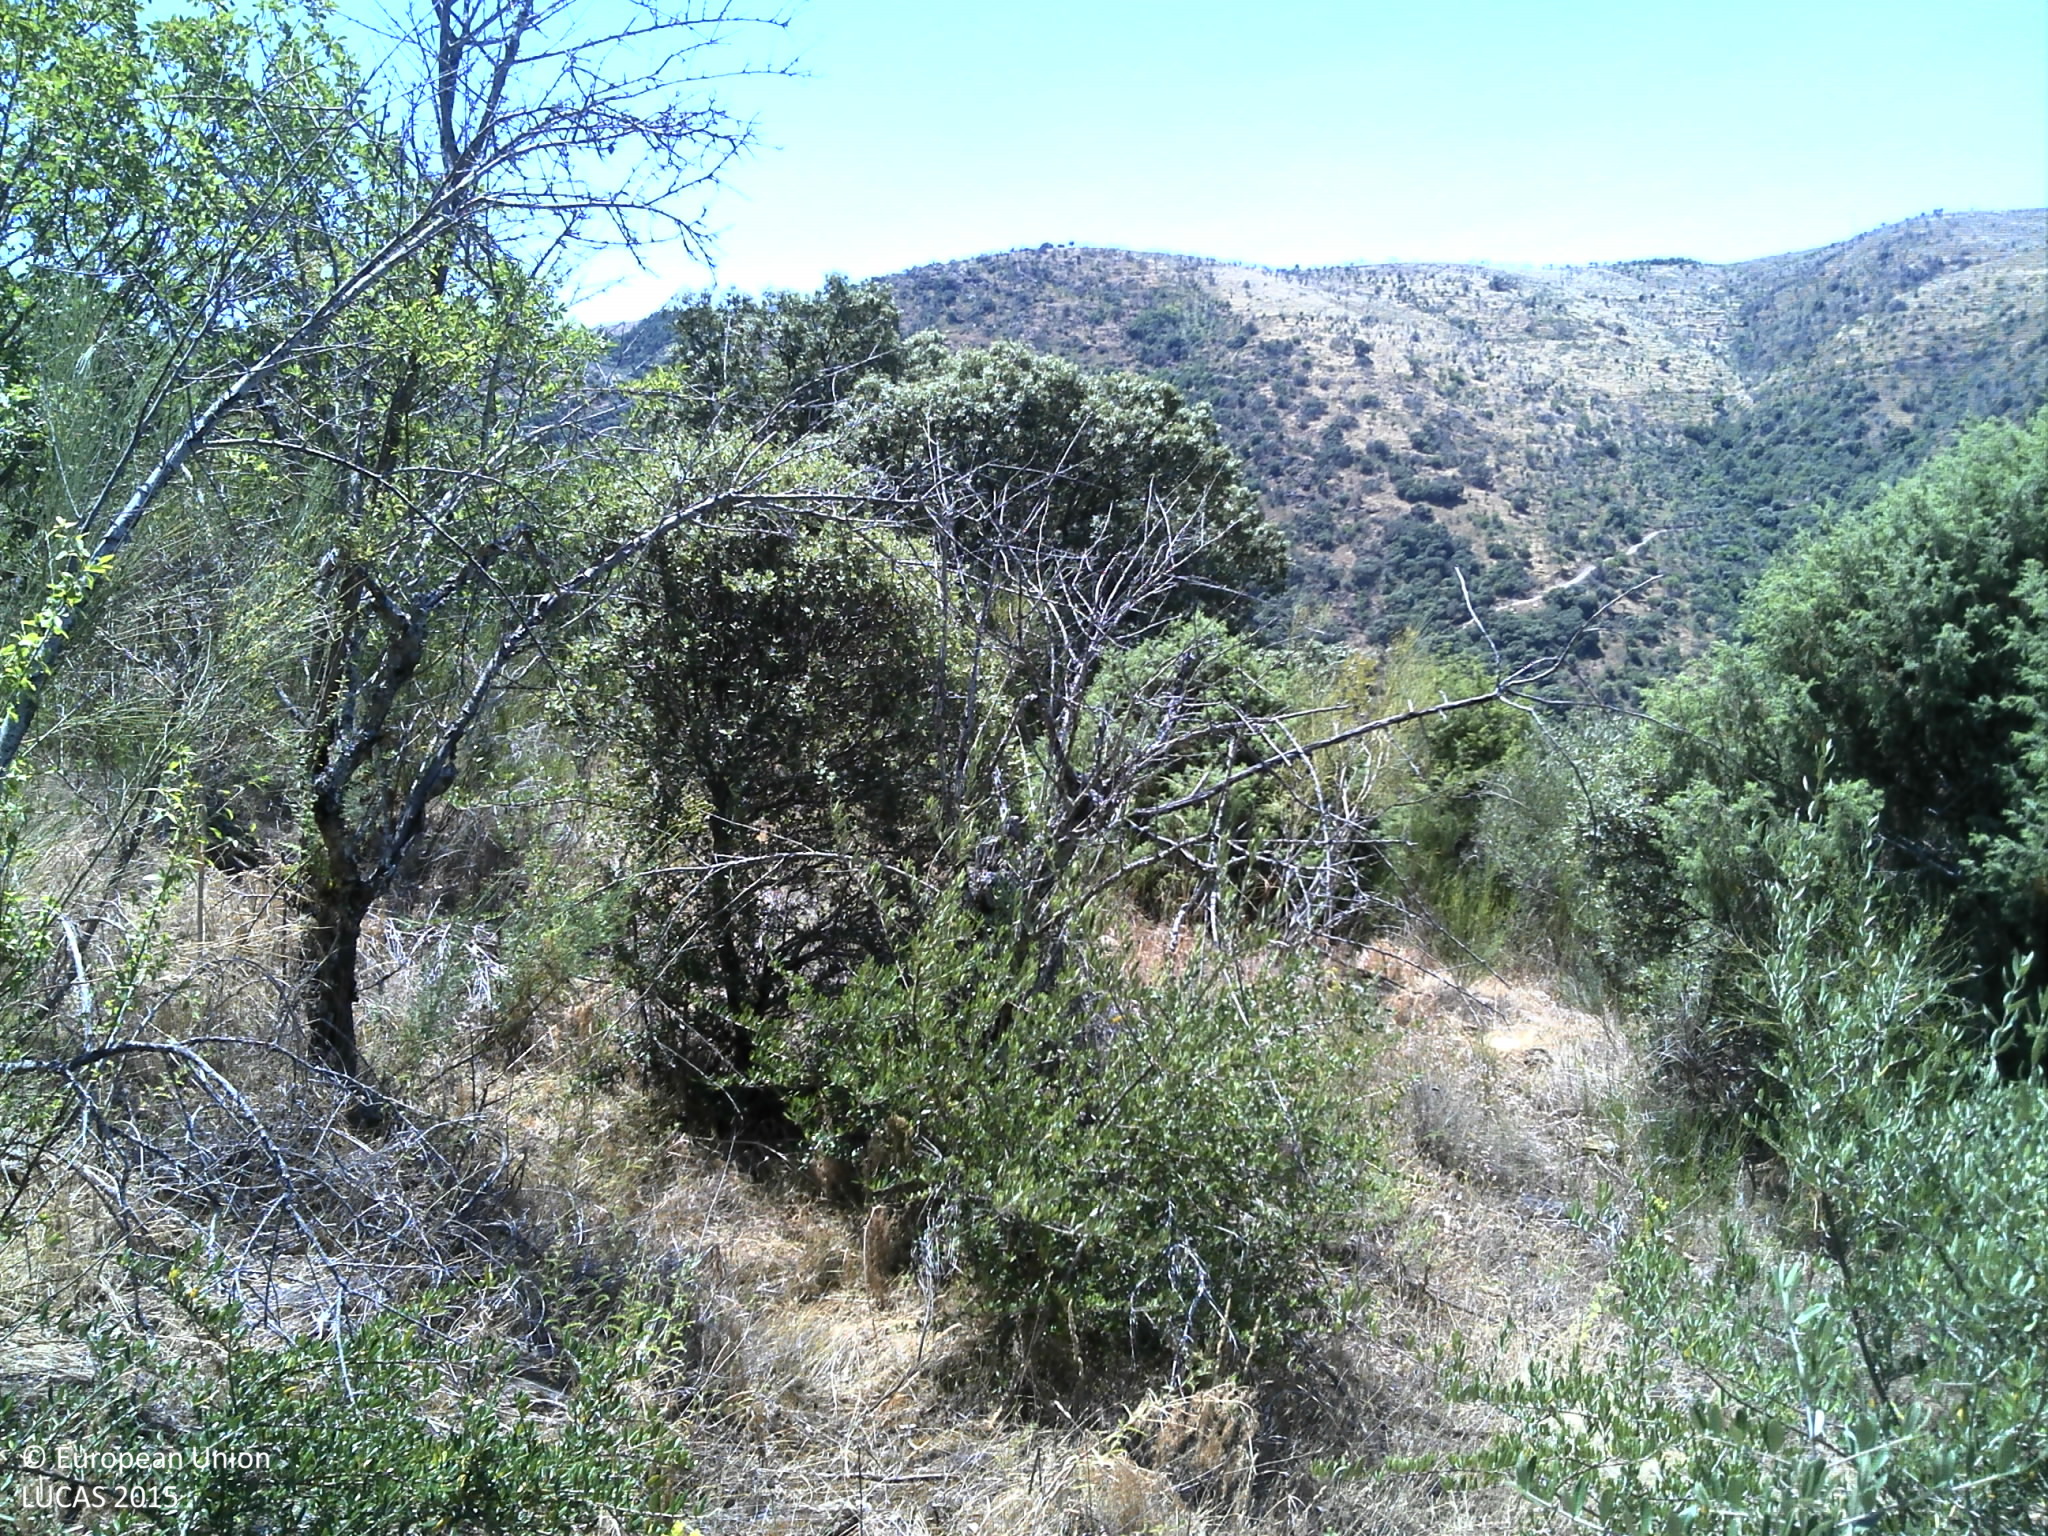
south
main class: Shrubland
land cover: Shrubland with sparse tree cover
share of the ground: 50 - 75 %
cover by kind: shrubs 75 %, unconsolidated bare surface 15 %, broadleaved forest trees 5 %, herbaceous plants 5 %
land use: Abandoned areas
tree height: > 5 m
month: June
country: PT
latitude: 41.2880
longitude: -6.8362
